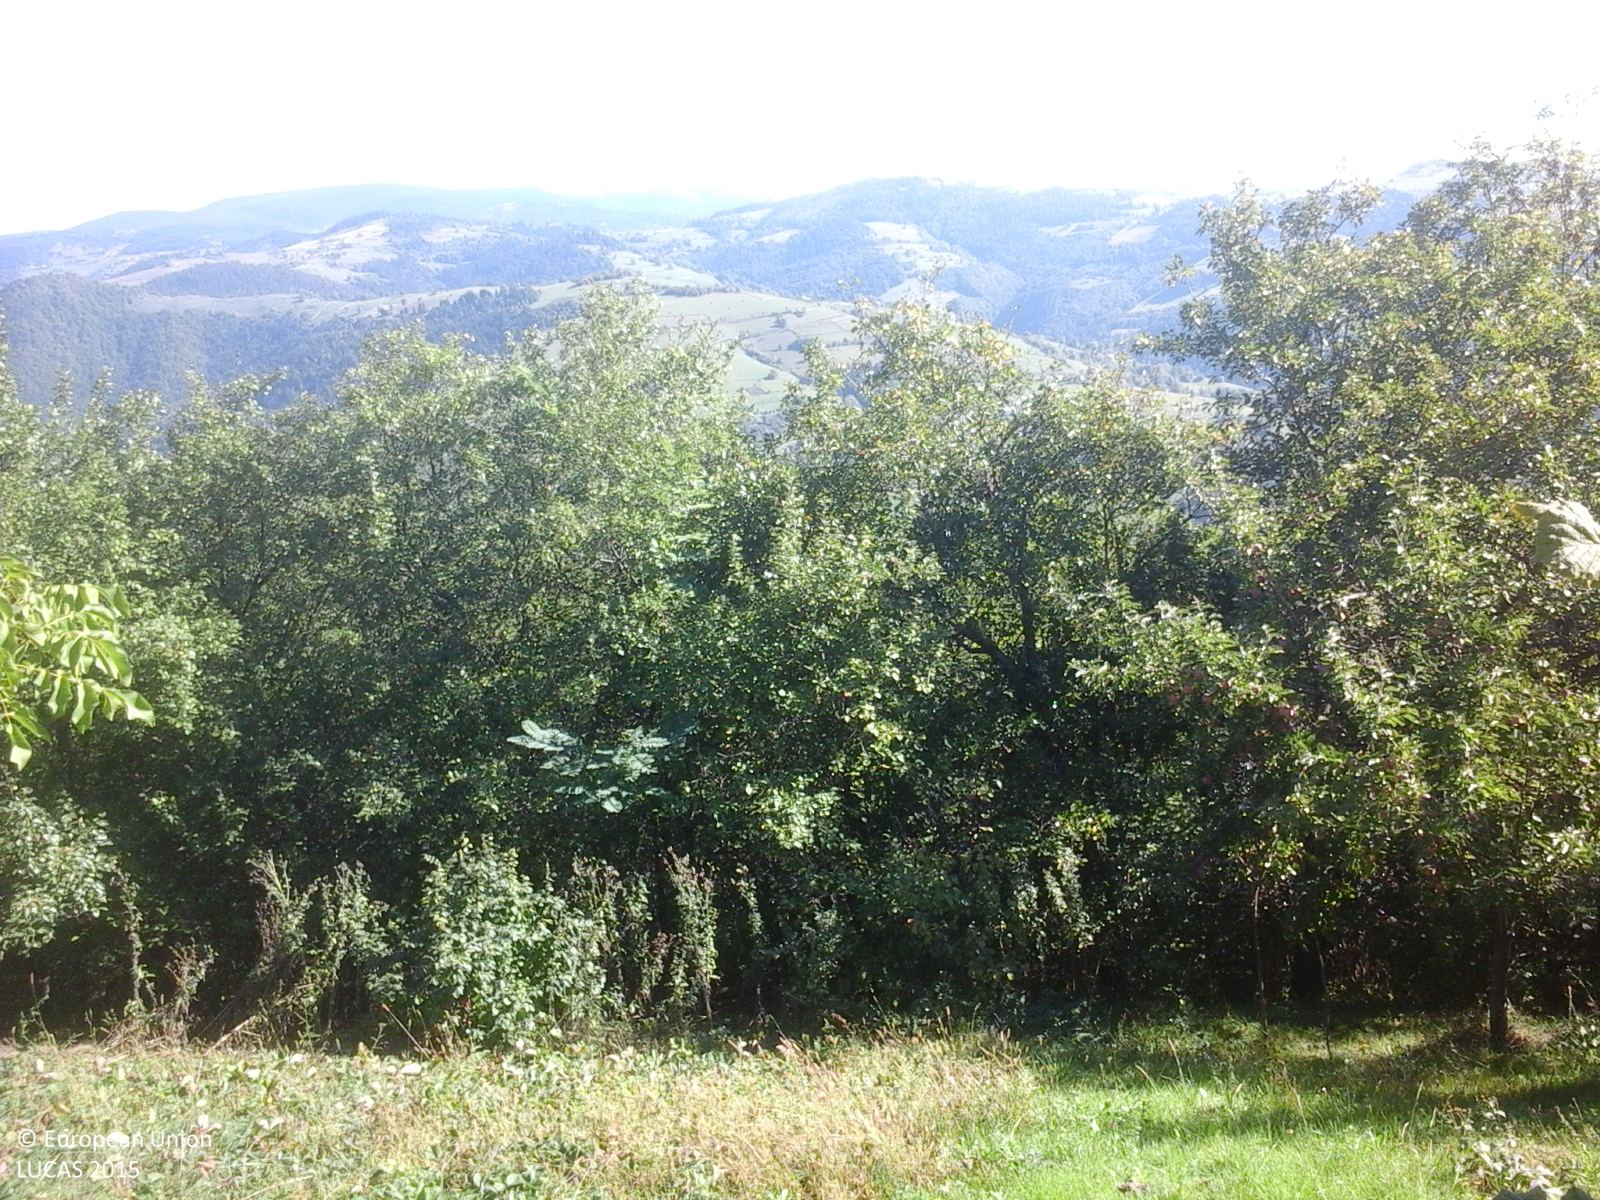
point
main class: Cropland
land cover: Apple fruit
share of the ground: > 75 %
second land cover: Grassland without tree/shrub cover
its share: > 75 %
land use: Agriculture (excluding fallow land and kitchen gardens)
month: October
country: RO
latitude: 46.4168
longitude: 22.9513
